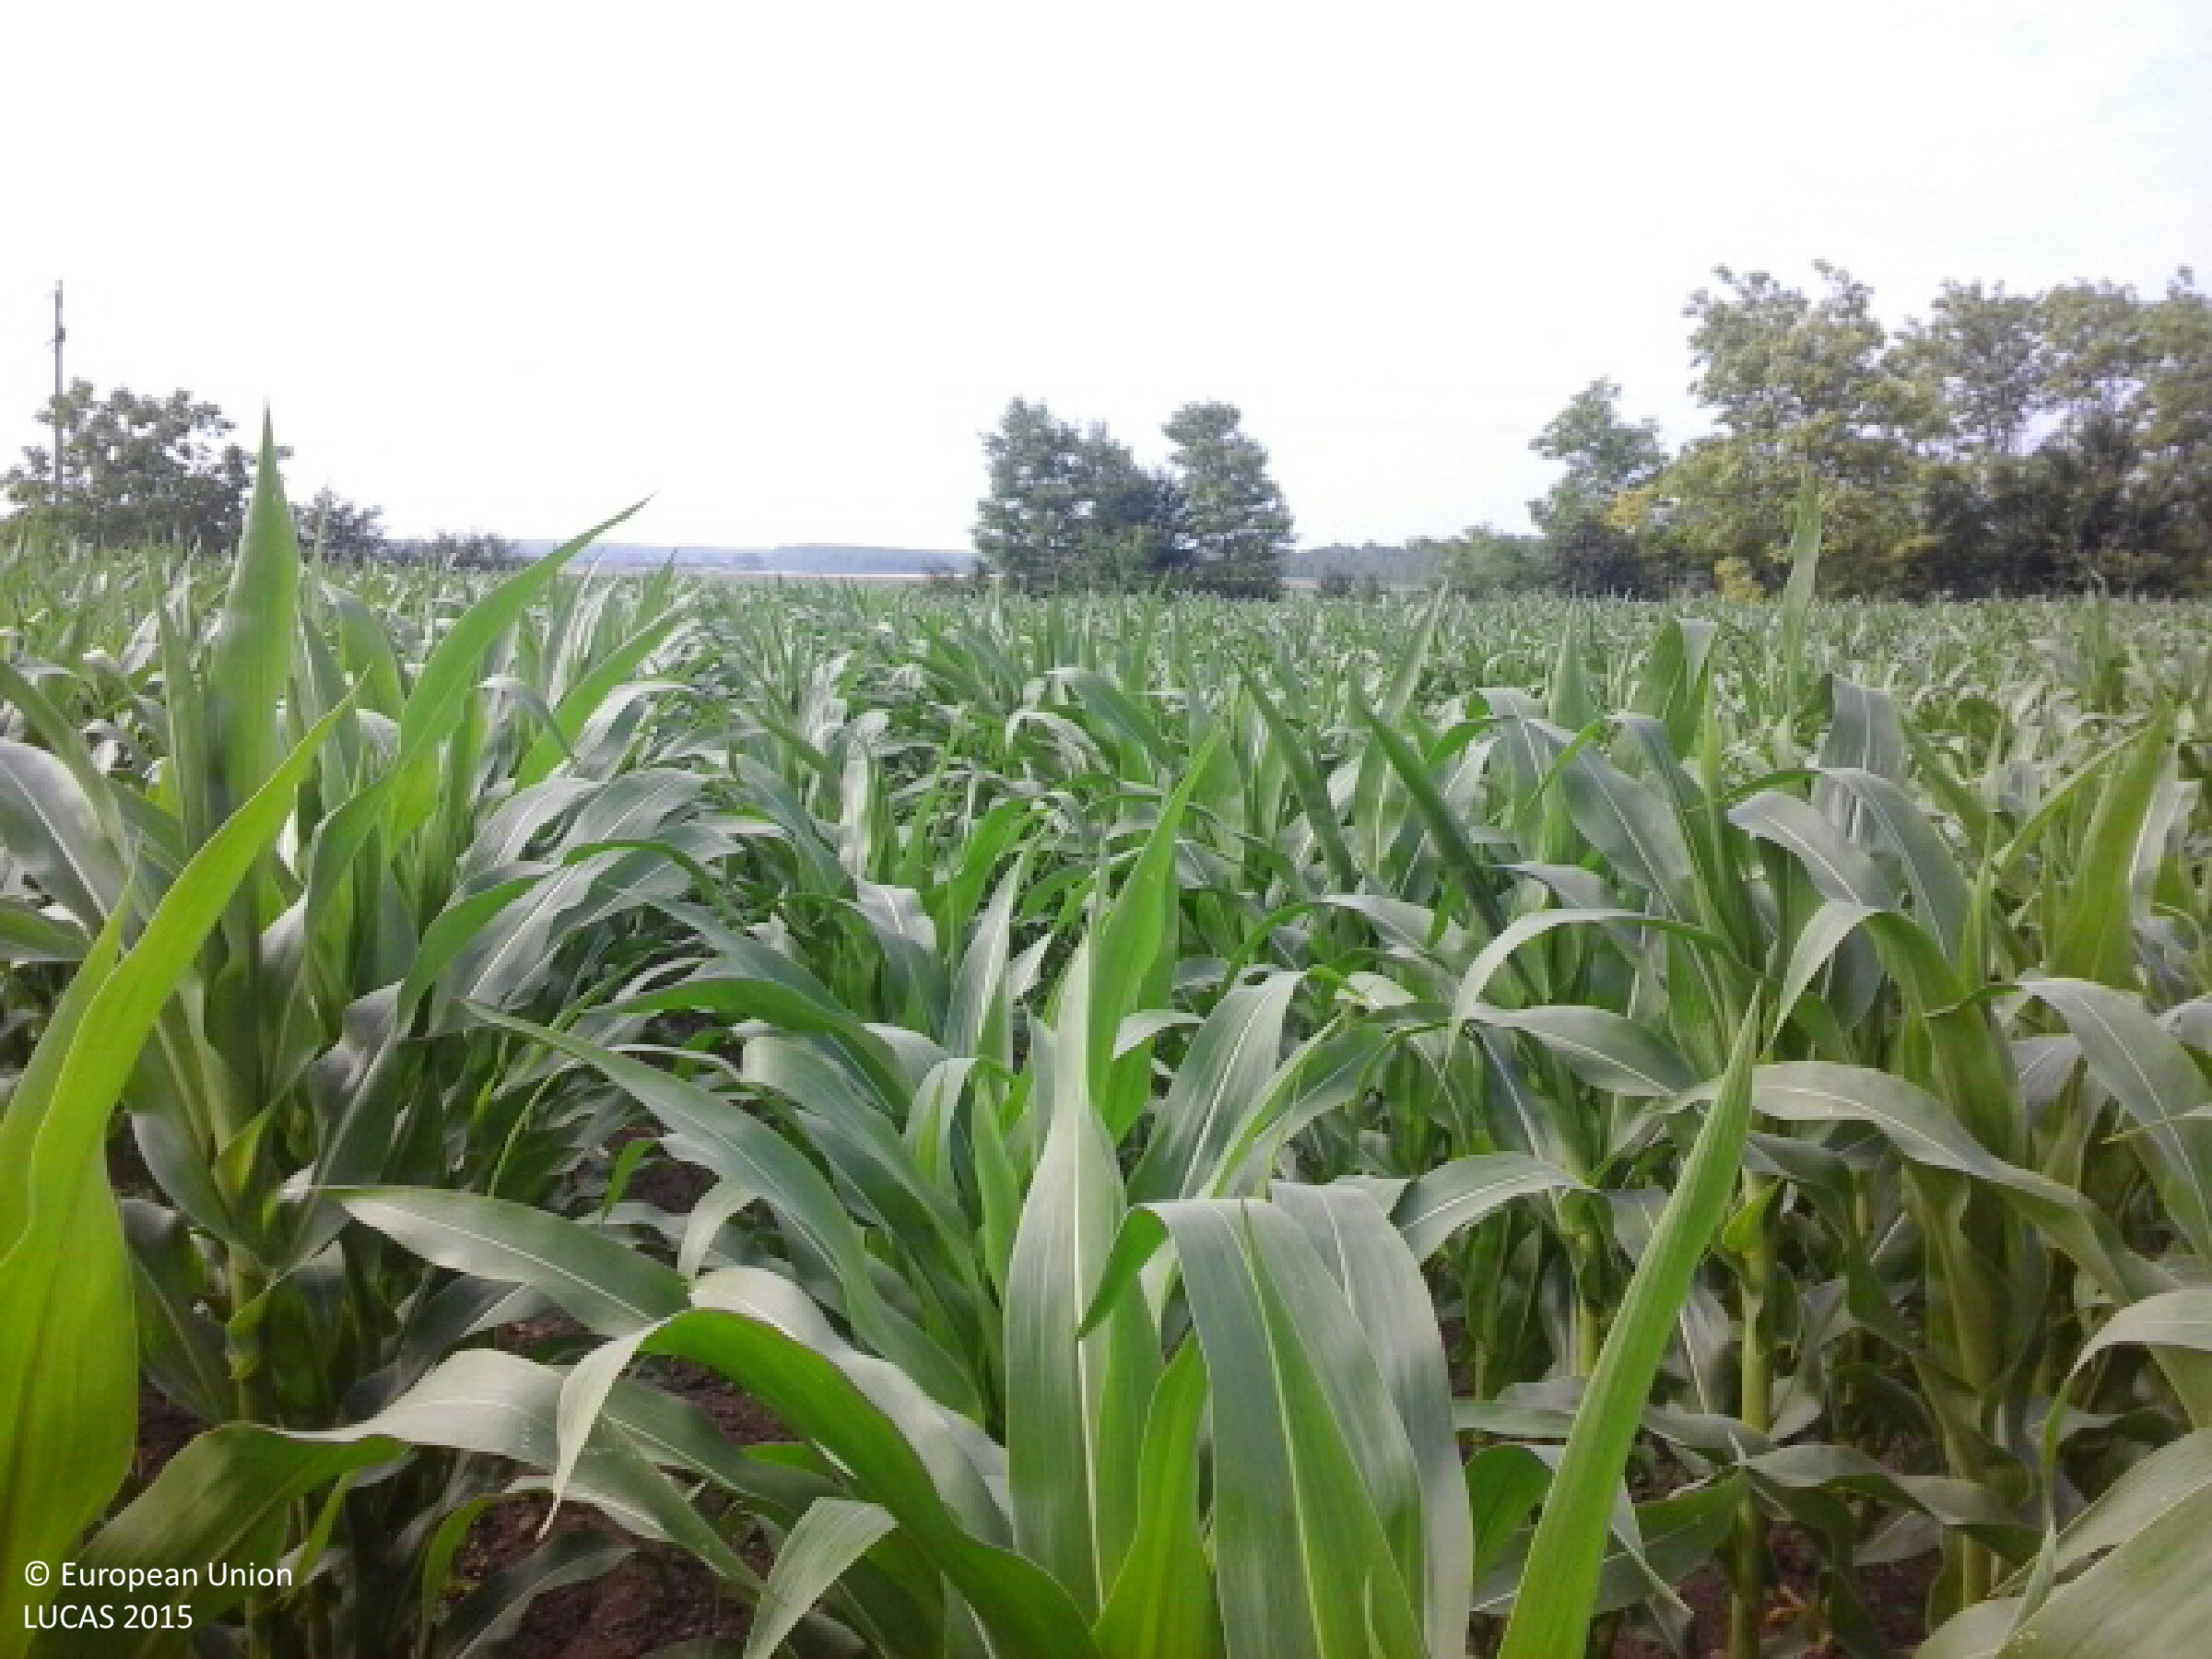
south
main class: Cropland
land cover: Maize
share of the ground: > 75 %
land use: Agriculture (excluding fallow land and kitchen gardens)
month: June
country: HU
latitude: 48.1089
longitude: 22.0196
